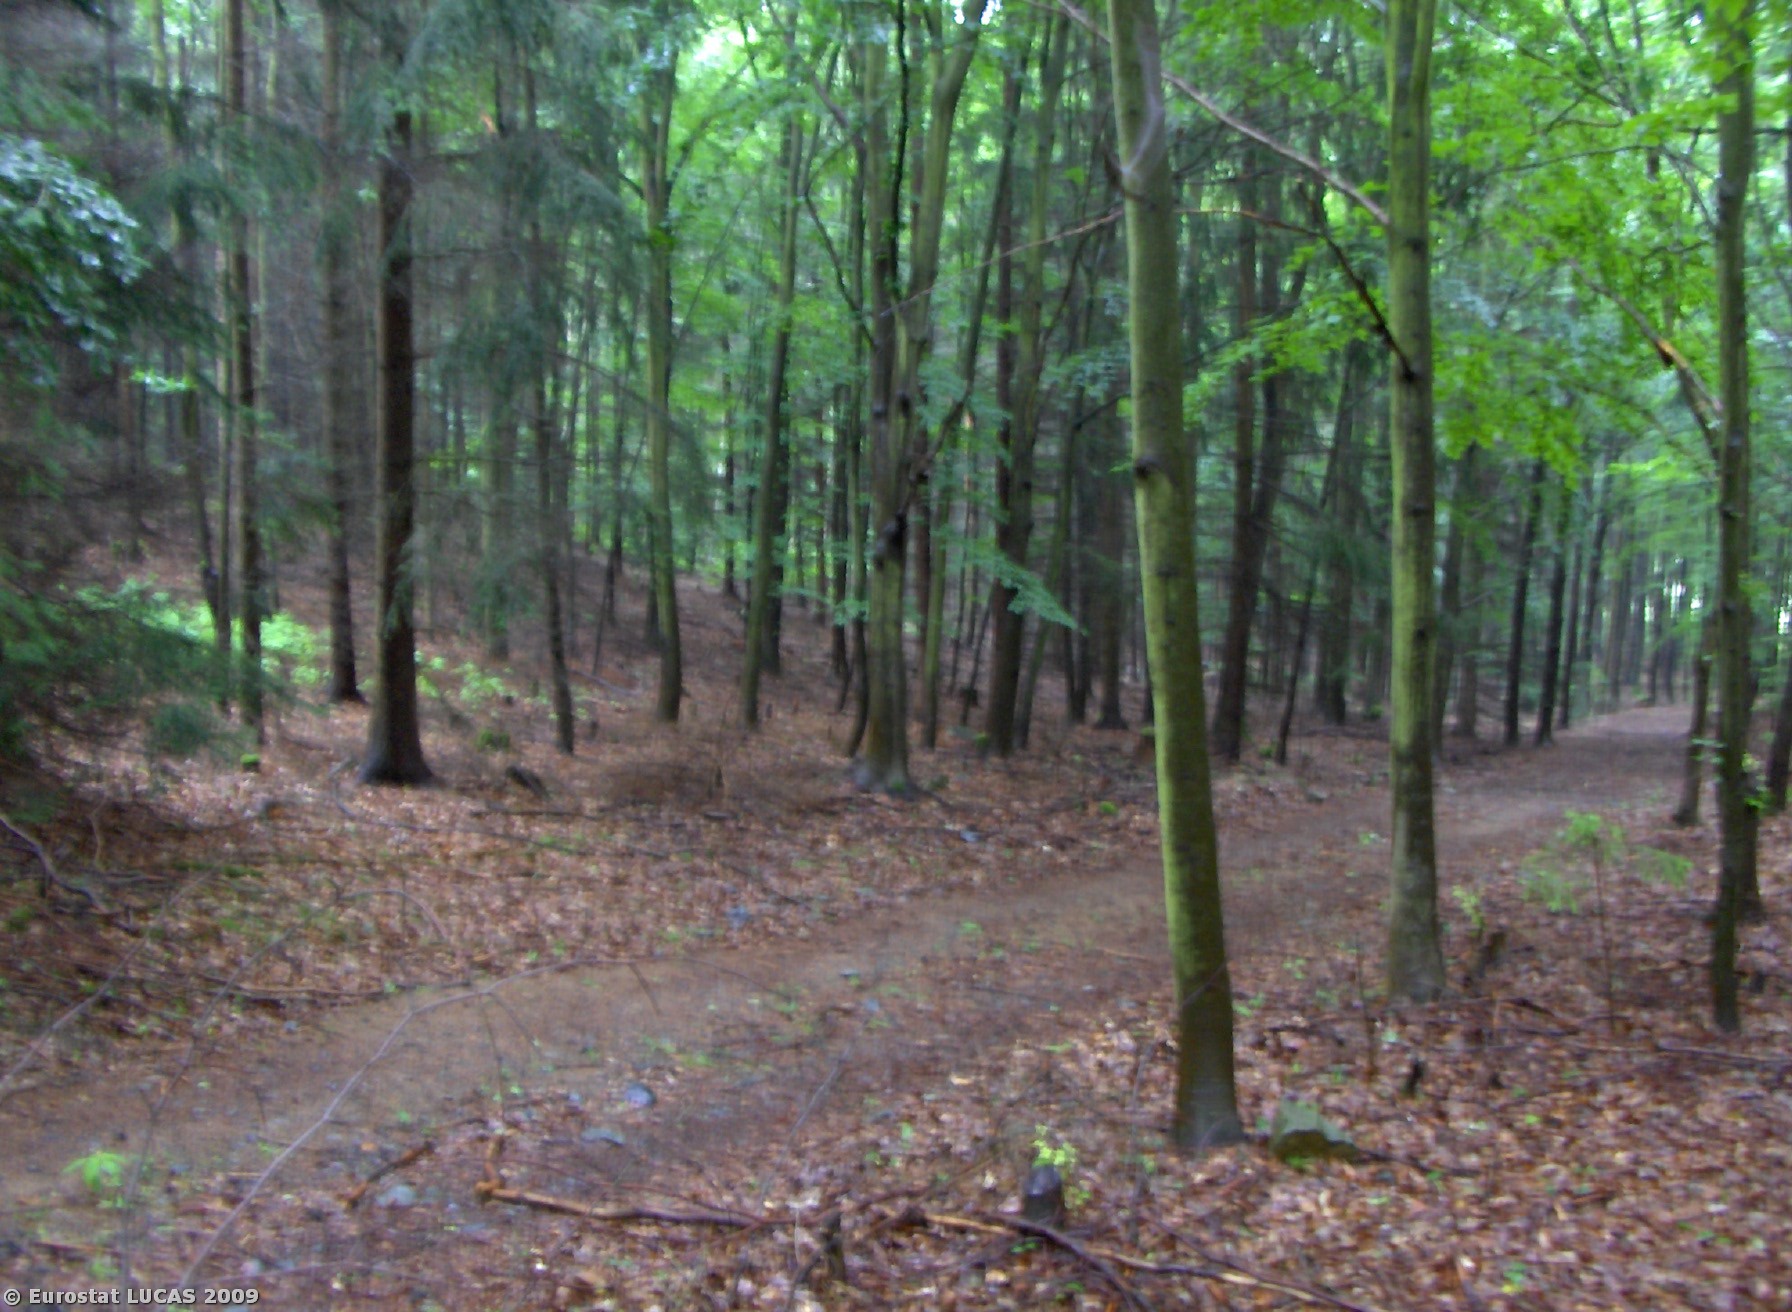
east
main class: Woodland
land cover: Broadleaved woodland
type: beech forest
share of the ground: > 75 %
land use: Forestry
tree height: > 5 m
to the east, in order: Broadleaved woodland; Tracks; Mixed woodland; Tracks; Mixed woodland; Coniferous woodland
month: June
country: CZ
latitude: 49.7106
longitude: 14.2030
